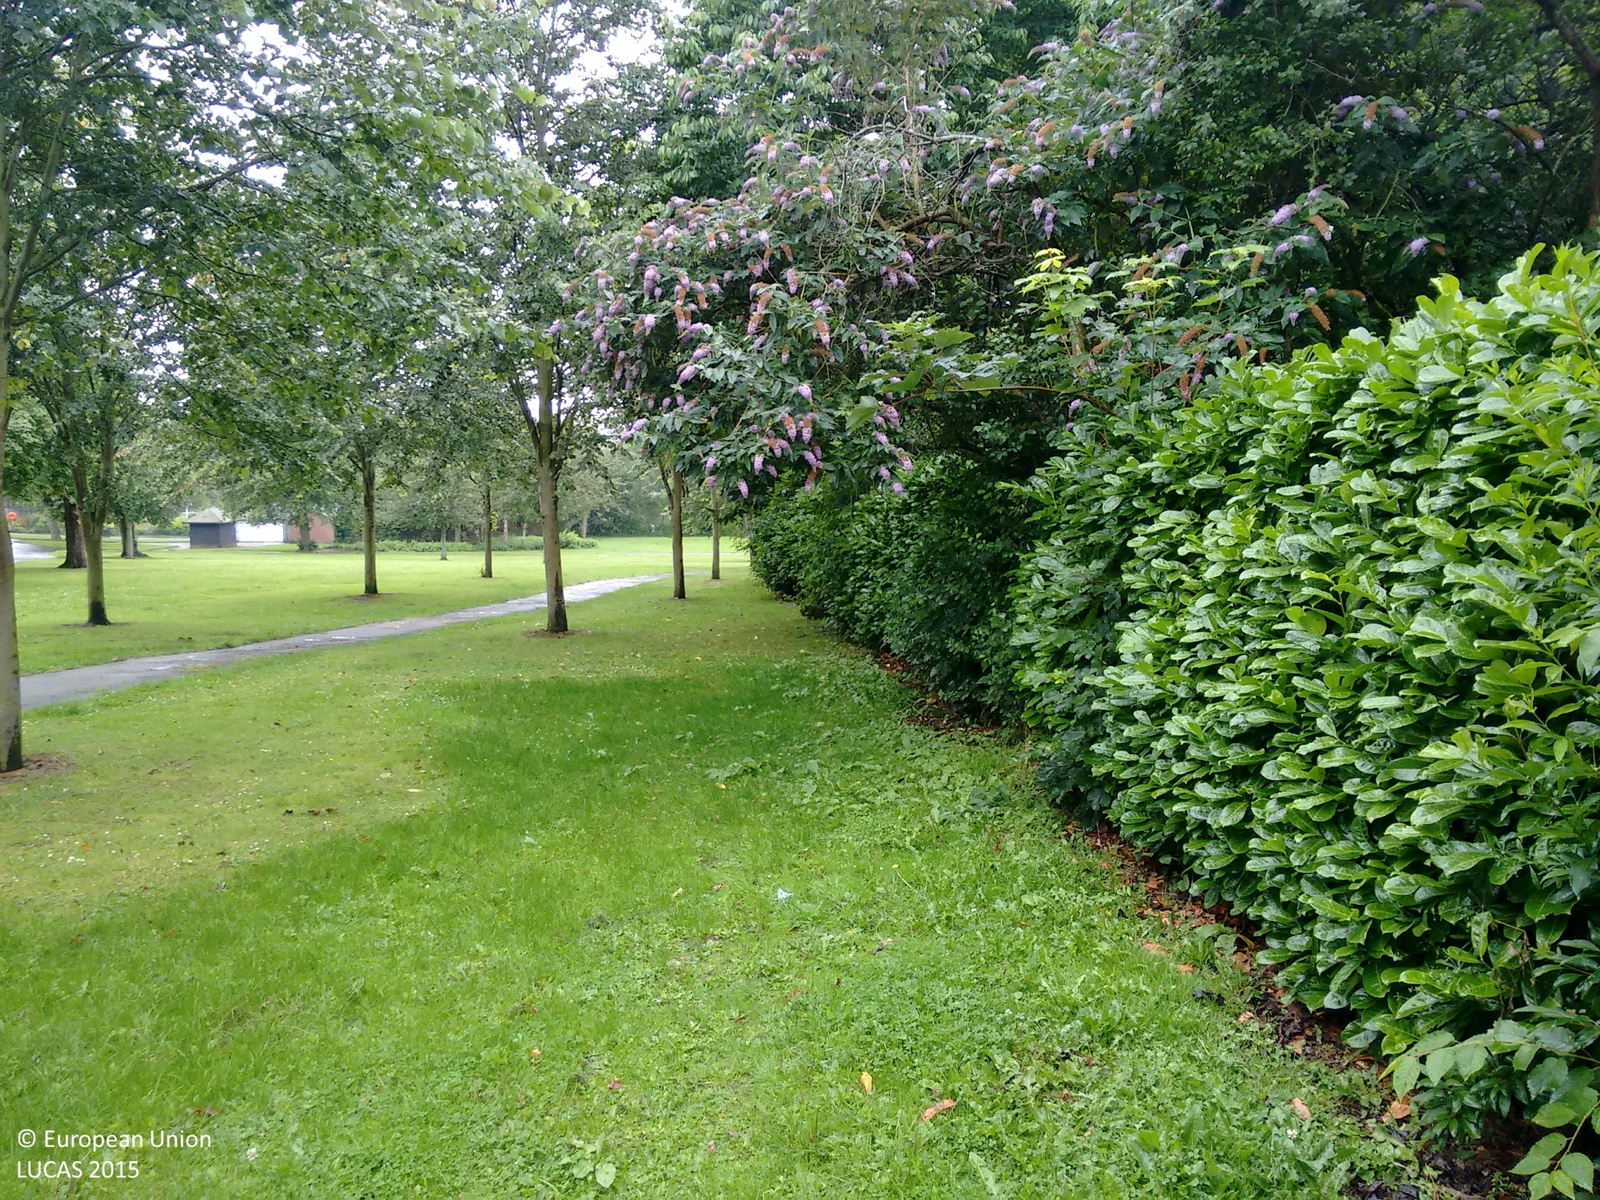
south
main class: Woodland
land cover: Broadleaved woodland
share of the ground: > 75 %
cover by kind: broadleaved forest trees 100 %
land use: Amenities, museums, leisure
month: July
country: GB
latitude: 54.8739
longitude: -2.9271
